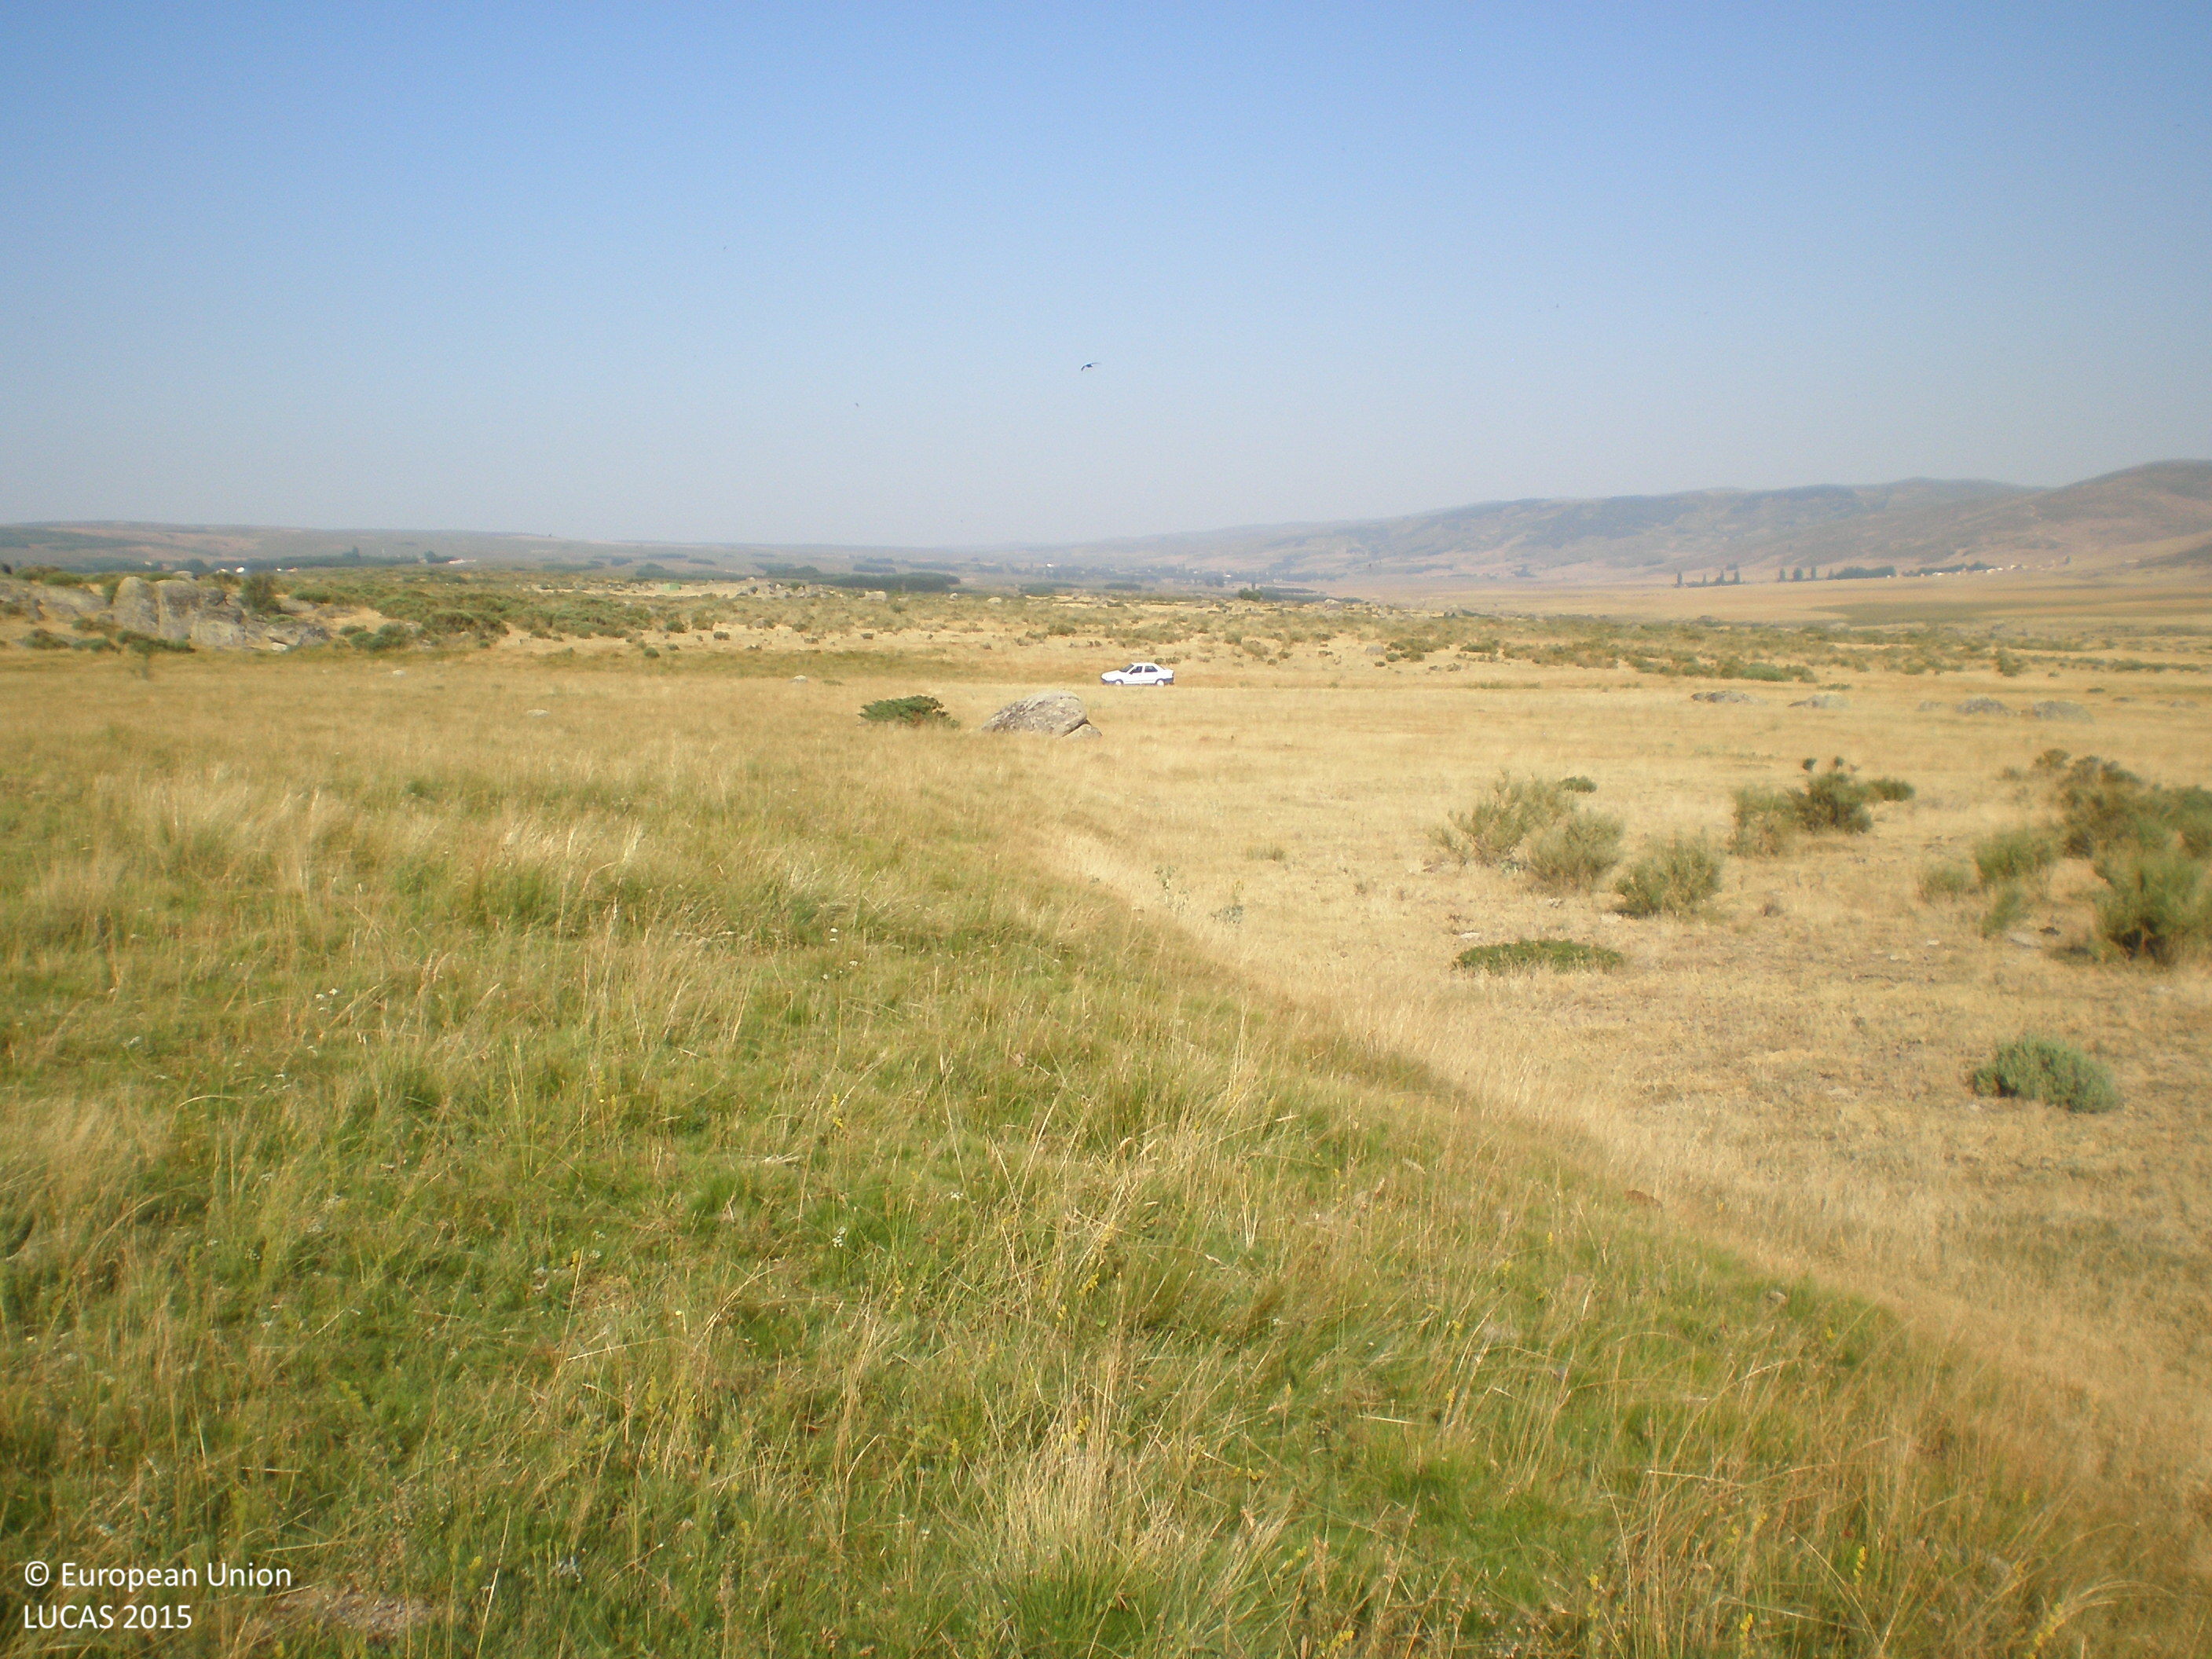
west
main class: Grassland
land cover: Grassland without tree/shrub cover
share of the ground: > 75 %
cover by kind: herbaceous plants 100 %
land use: Agriculture (excluding fallow land and kitchen gardens)
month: July
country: ES
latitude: 40.4407
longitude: -5.0426
